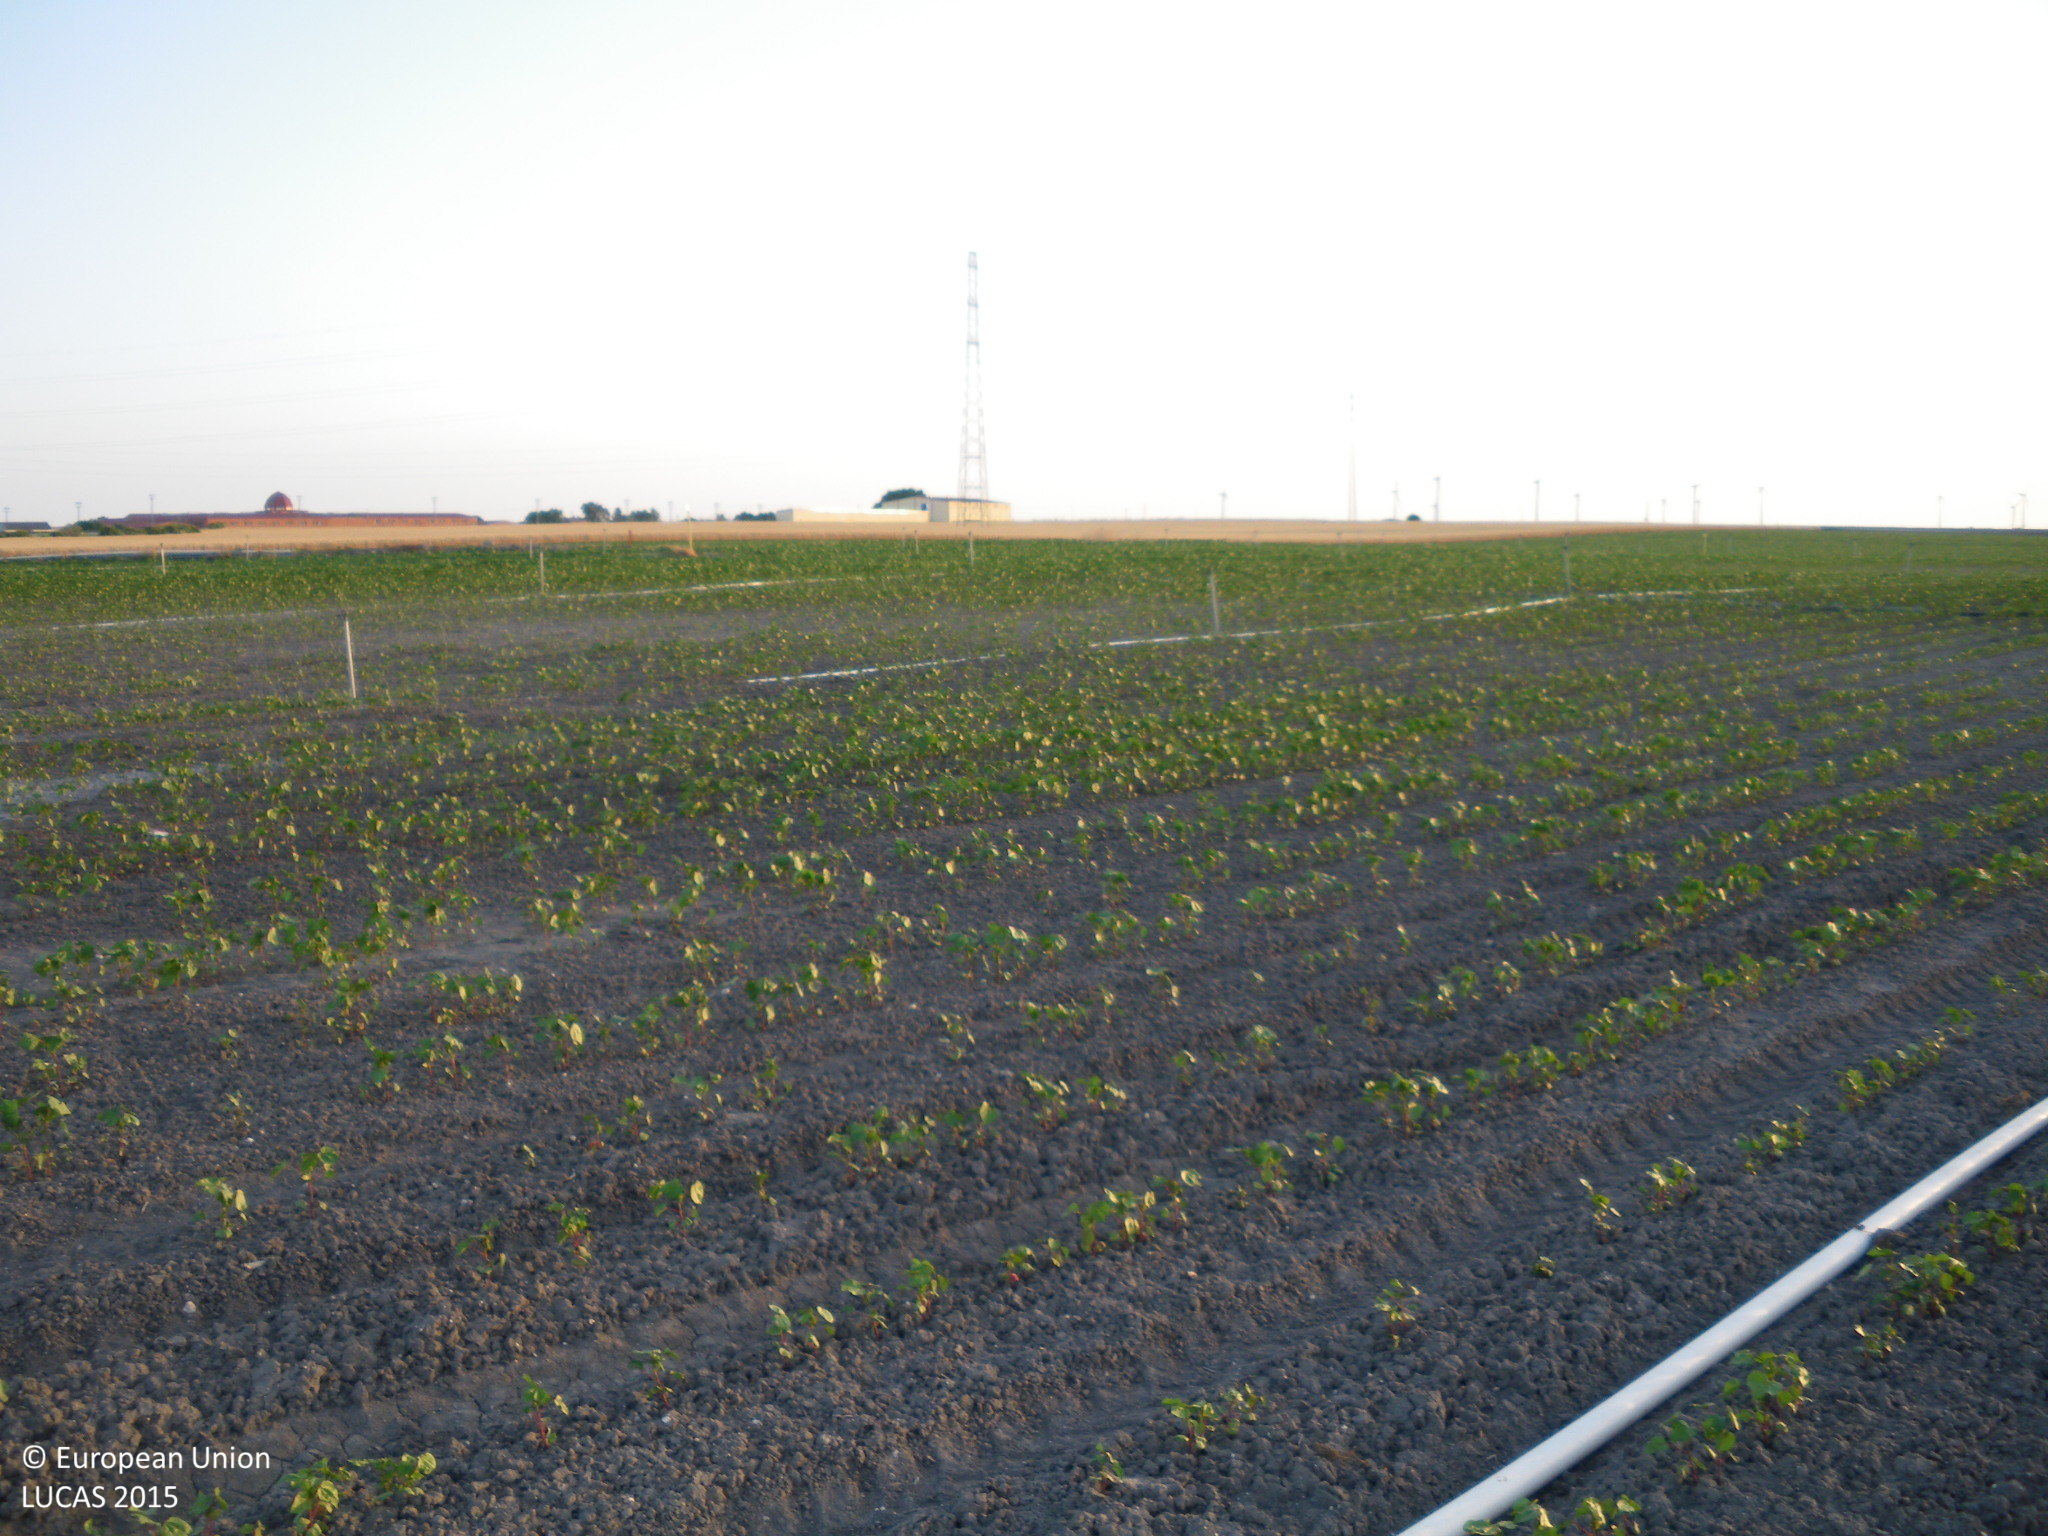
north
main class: Cropland
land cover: Cotton
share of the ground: < 10 %
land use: Agriculture (excluding fallow land and kitchen gardens)
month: June
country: ES
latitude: 36.6543
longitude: -6.2451
